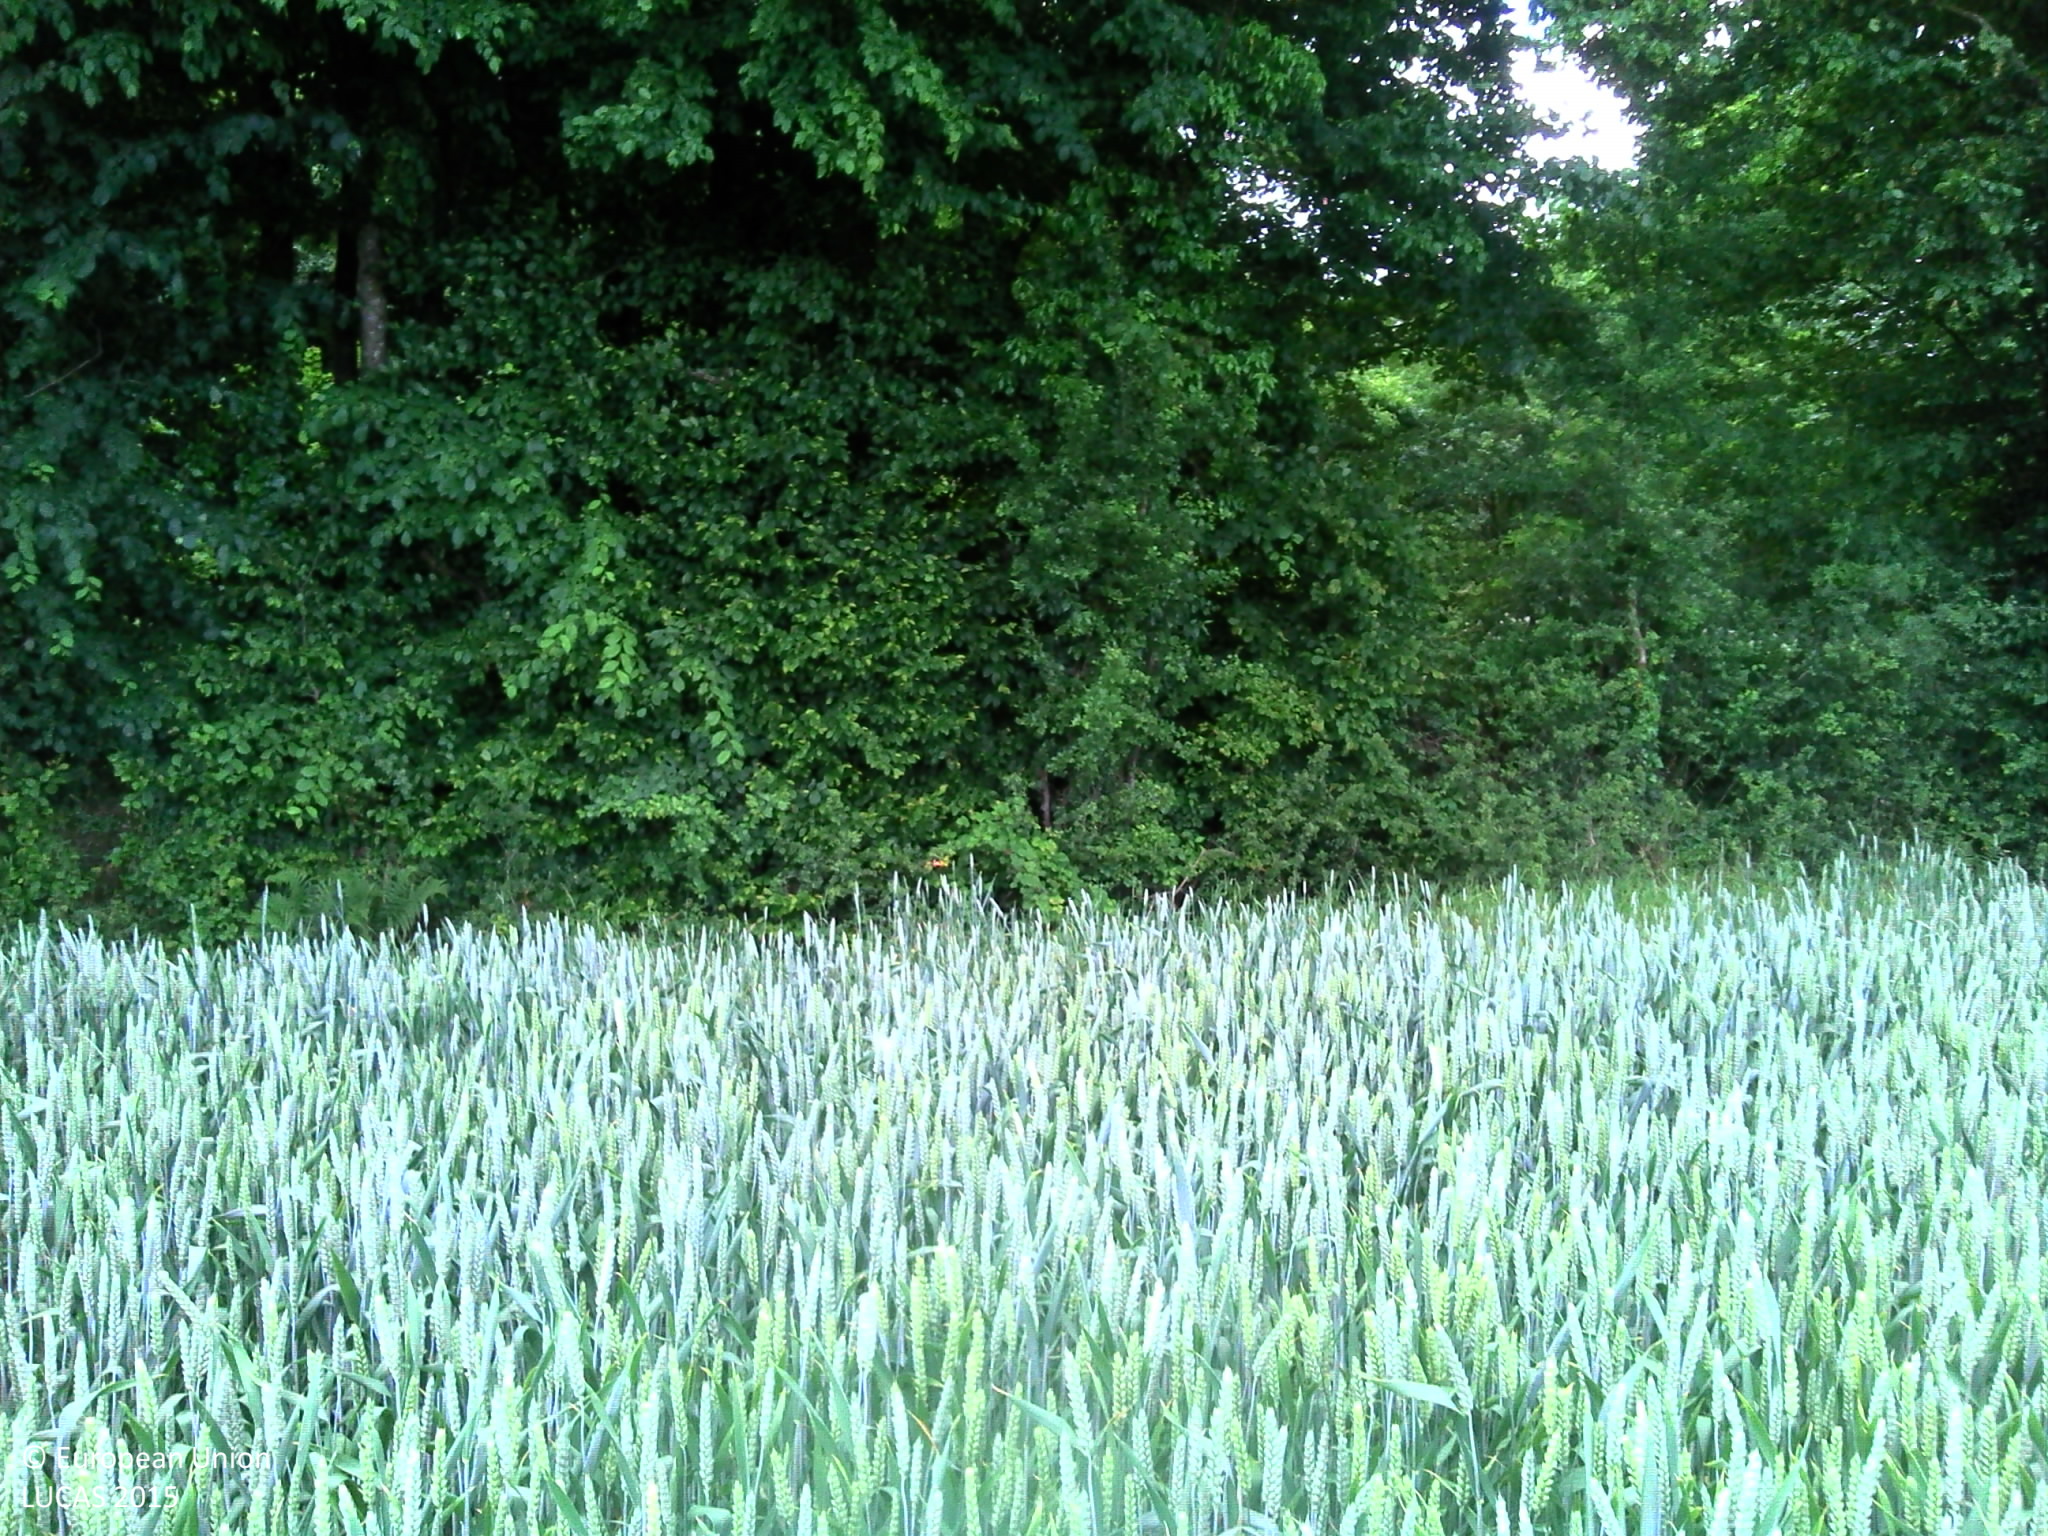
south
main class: Cropland
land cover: Common wheat
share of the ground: > 75 %
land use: Agriculture (excluding fallow land and kitchen gardens)
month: June
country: FR
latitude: 49.0212
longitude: 0.4423
